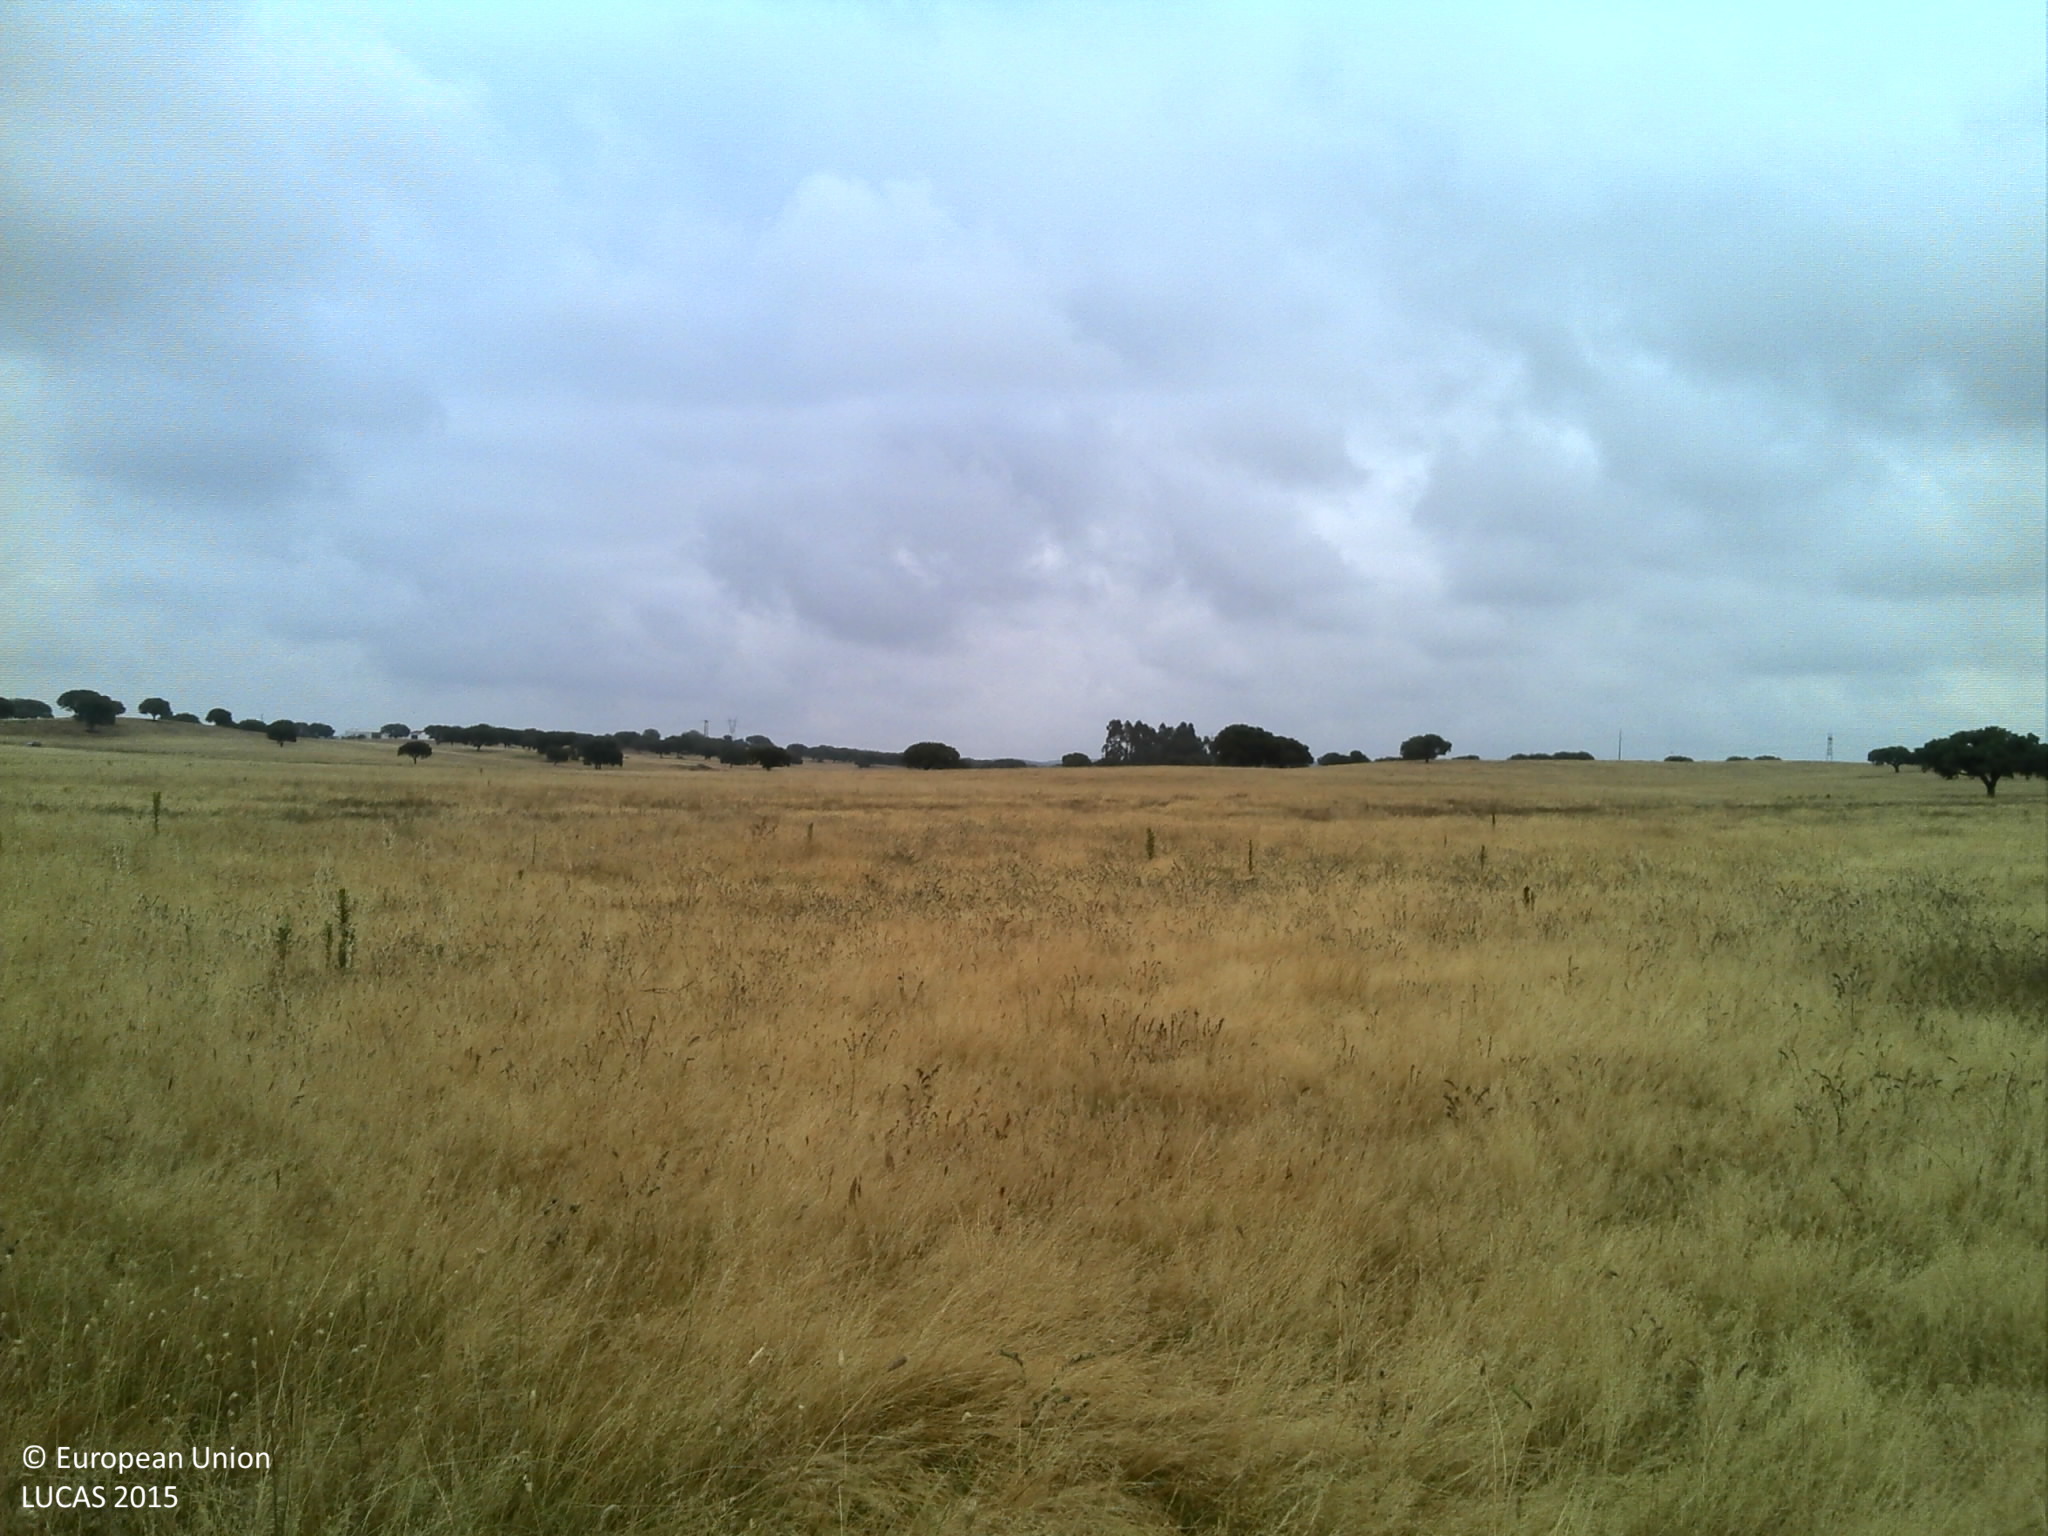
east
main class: Grassland
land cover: Grassland without tree/shrub cover
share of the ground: > 75 %
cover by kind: herbaceous plants 90 %, unconsolidated bare surface 10 %
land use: Agriculture (excluding fallow land and kitchen gardens)
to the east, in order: Grassland without tree/shrub cover; Rivers and streams; Grassland without tree/shrub cover
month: June
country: PT
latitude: 38.3702
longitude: -7.9728
